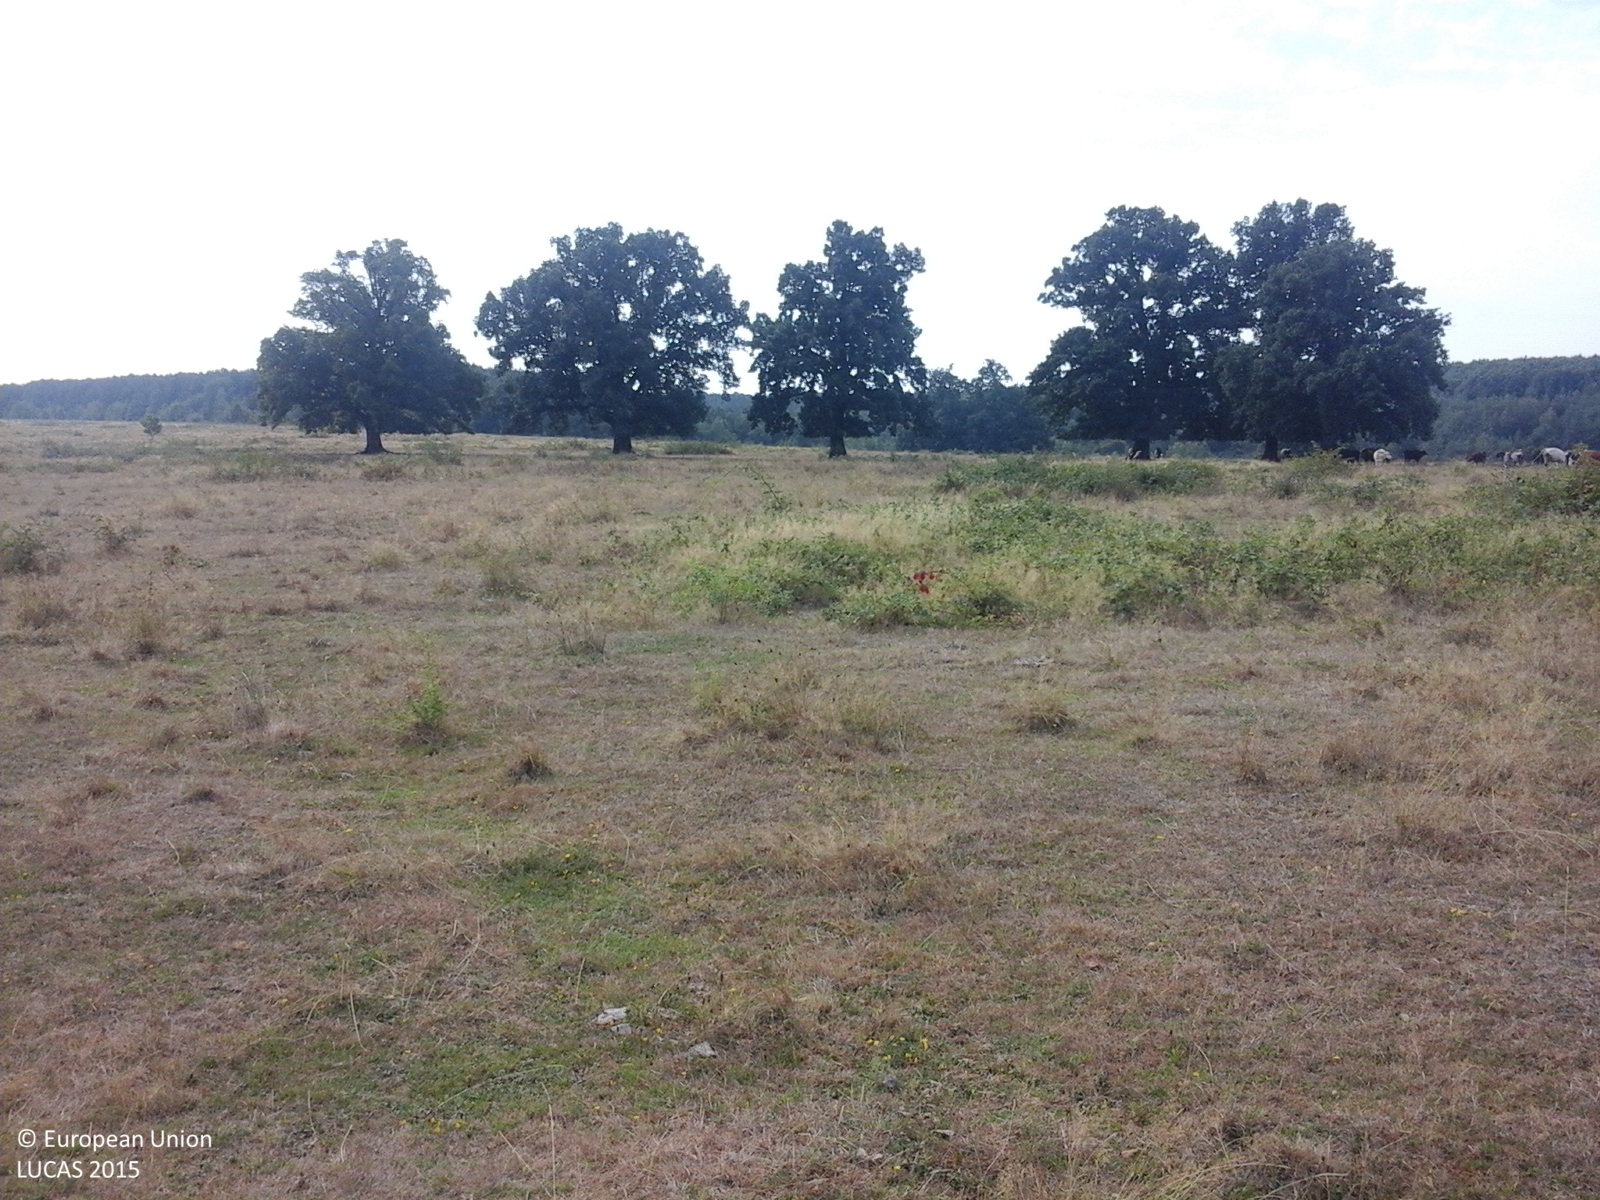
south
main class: Grassland
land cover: Grassland with sparse tree/shrub cover
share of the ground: > 75 %
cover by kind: herbaceous plants 85 %, shrubs 10 %, broadleaved forest trees 5 %
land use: Agriculture (excluding fallow land and kitchen gardens)
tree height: < 5 m
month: August
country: RO
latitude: 46.3601
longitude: 22.1985
